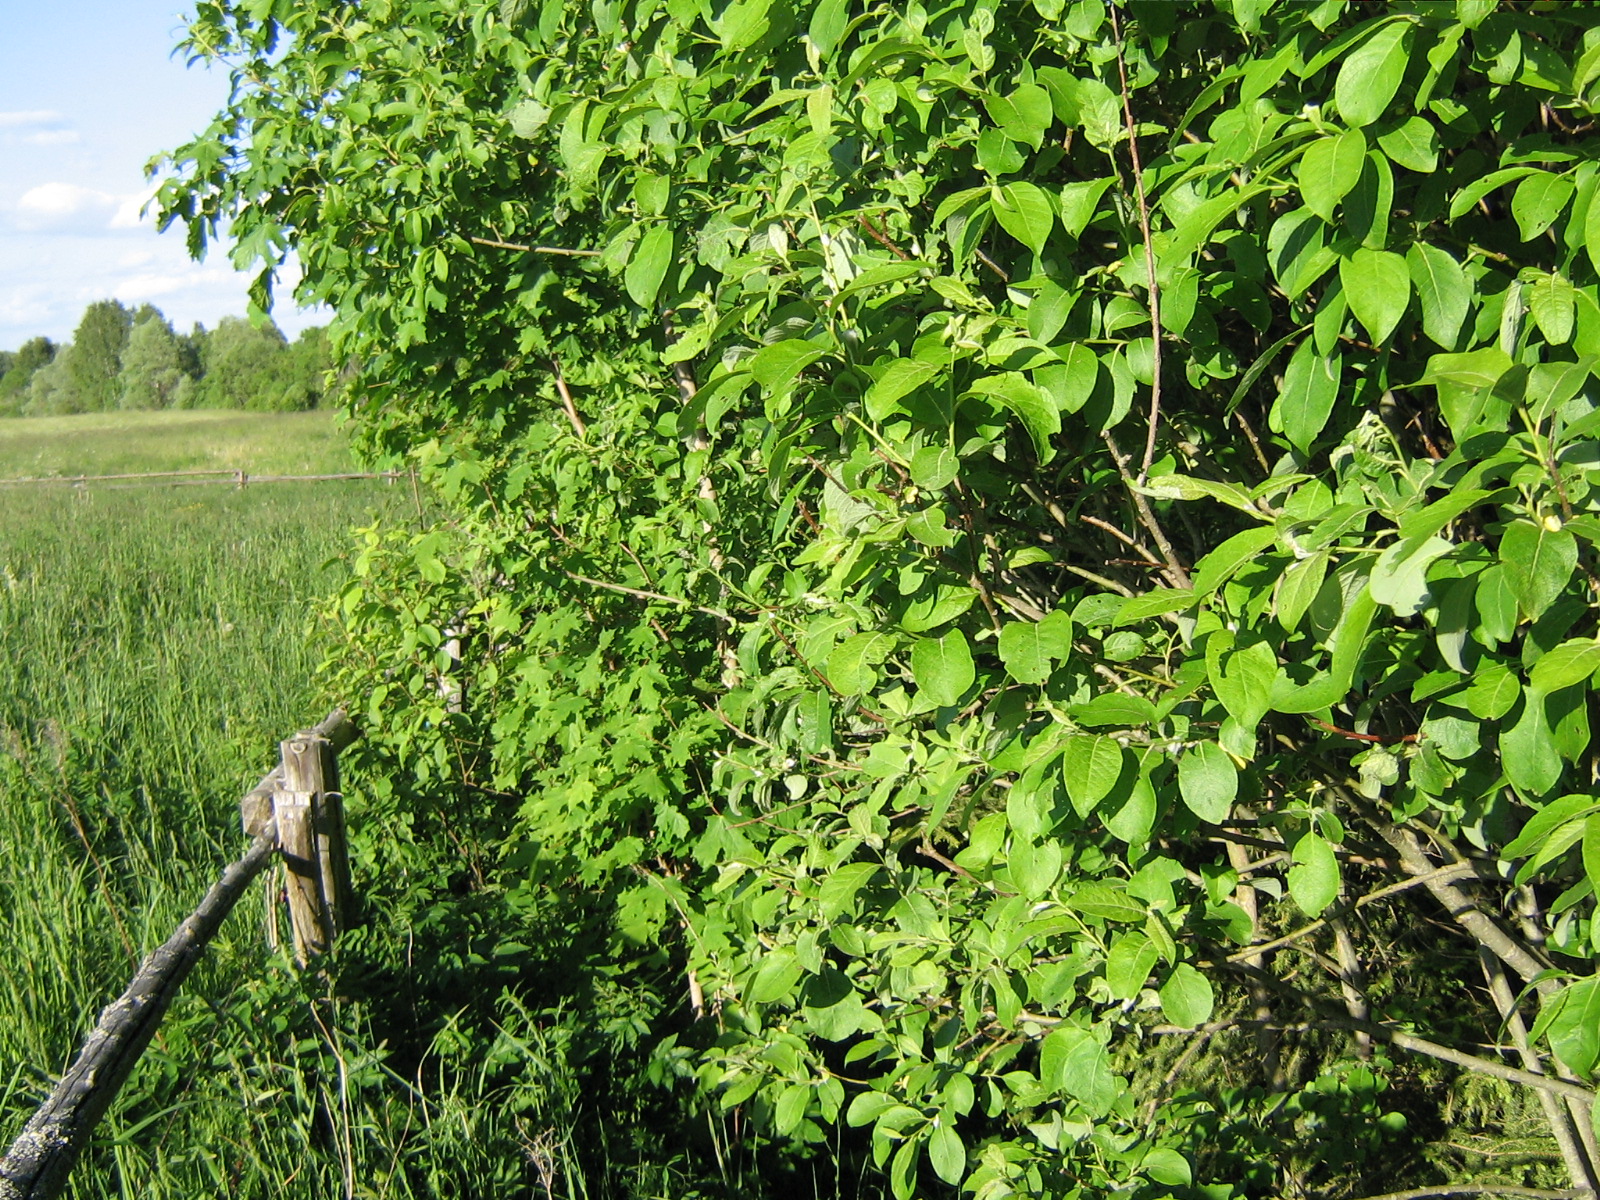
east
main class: Grassland
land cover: Grassland without tree/shrub cover
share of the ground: > 75 %
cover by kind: herbaceous plants 100 %
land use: Agriculture (excluding fallow land and kitchen gardens)
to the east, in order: Grassland without tree/shrub cover; Fences; Grassland without tree/shrub cover; Abandoned hedges; Ditches and canals; Abandoned hedges; Grassland without tree/shrub cover
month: June
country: LV
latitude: 57.1555
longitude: 25.8818
